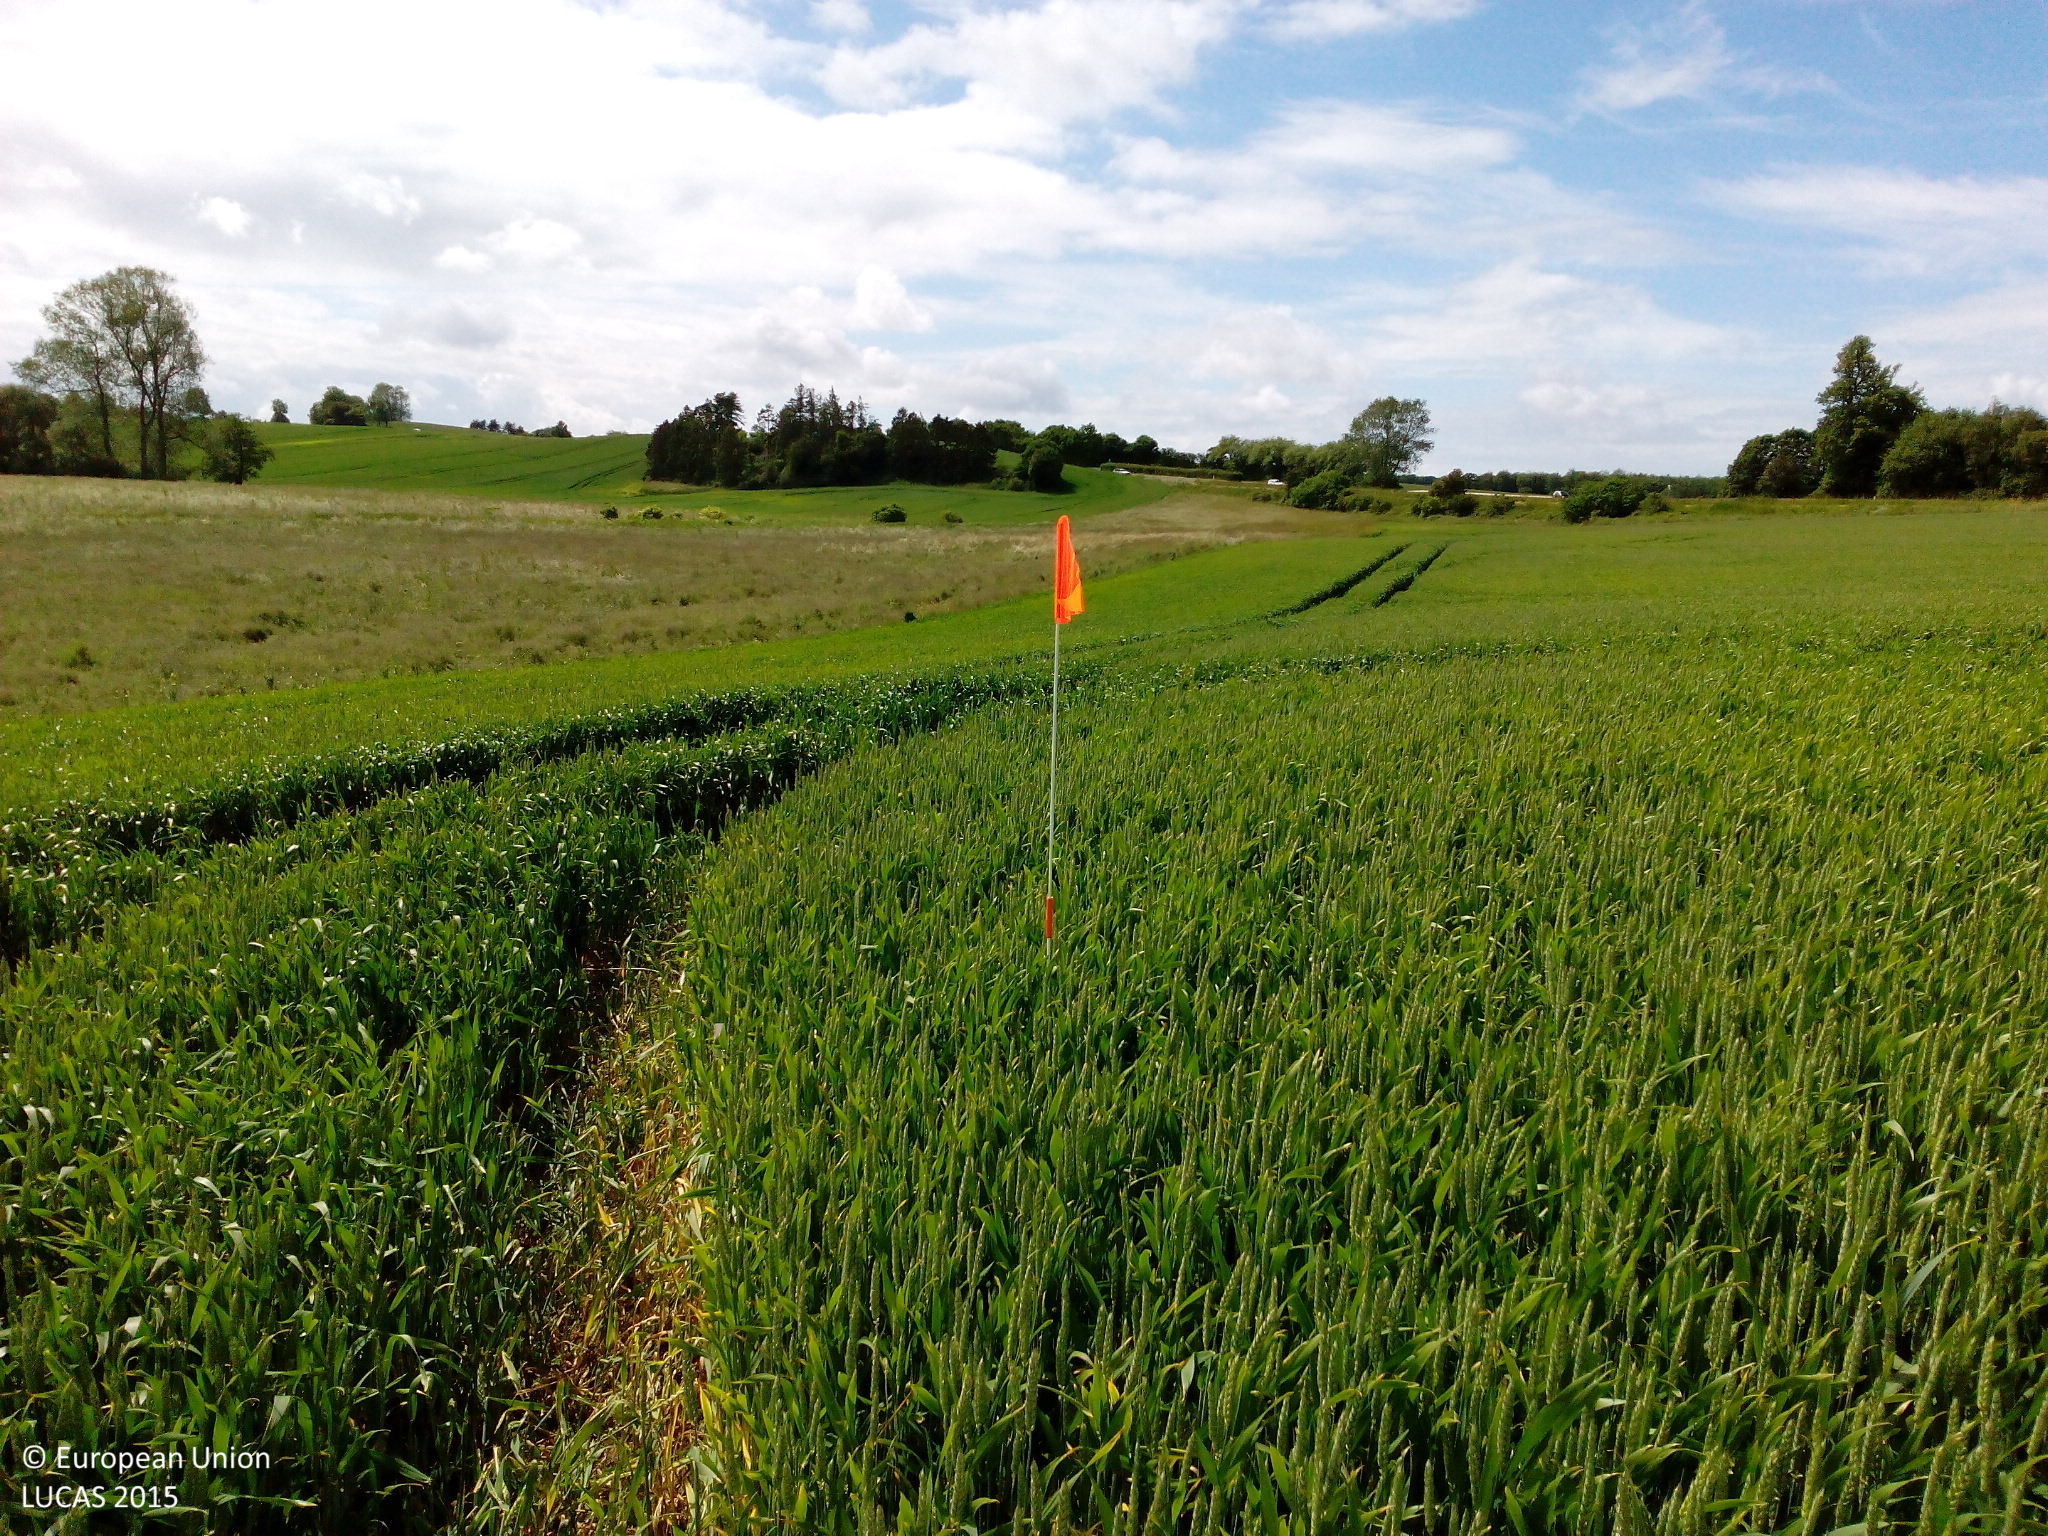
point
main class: Cropland
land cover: Common wheat
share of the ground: > 75 %
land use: Agriculture (excluding fallow land and kitchen gardens)
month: June
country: DK
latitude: 54.9807
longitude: 10.8275
